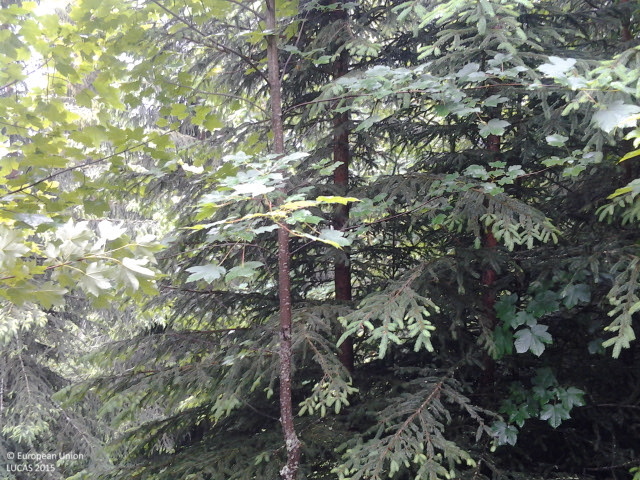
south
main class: Woodland
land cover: Spruce dominated mixed woodland
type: alpine coniferous forest
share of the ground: > 75 %
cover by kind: coniferous forest trees 70 %, broadleaved forest trees 30 %
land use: Forestry
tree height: > 5 m
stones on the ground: 25 - 50 %
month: June
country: RO
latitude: 47.2581
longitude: 25.2933
